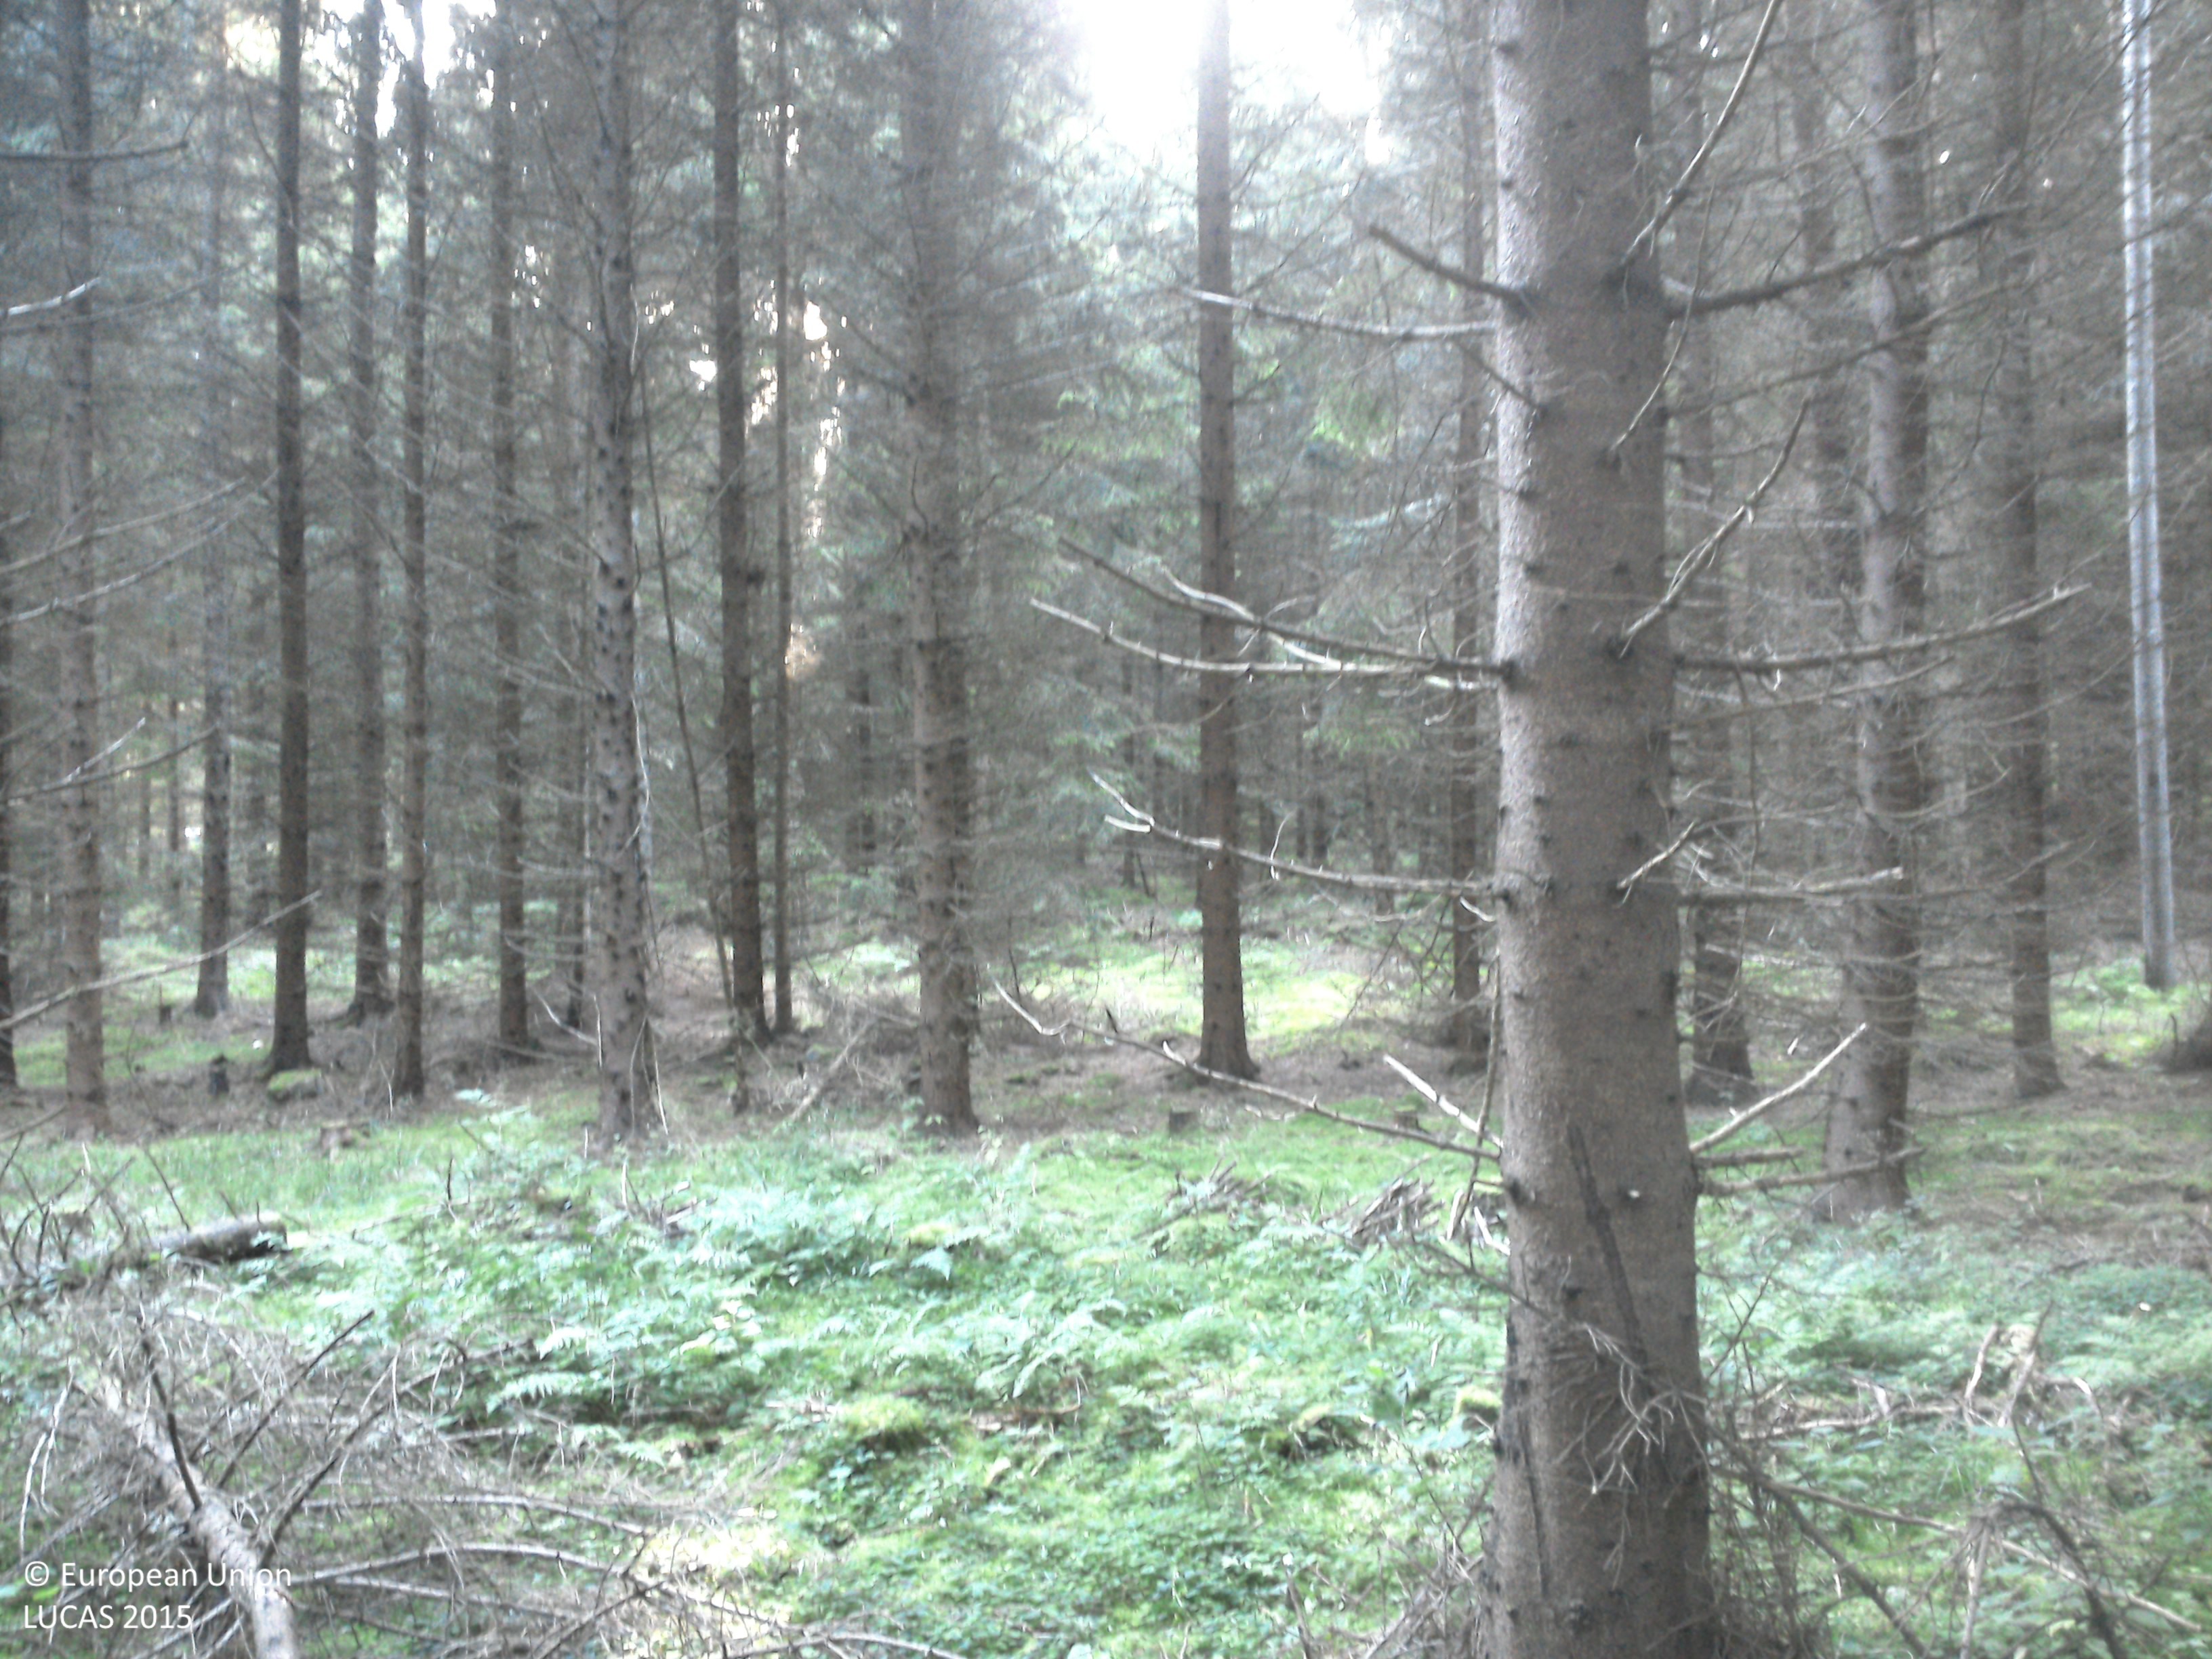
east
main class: Woodland
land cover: Spruce dominated coniferous woodland
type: boreal forest
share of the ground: > 75 %
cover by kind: coniferous forest trees 90 %, lichens and mosses 5 %, unconsolidated bare surface 5 %
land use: Forestry
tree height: > 5 m
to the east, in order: Spruce dominated coniferous woodland; Electric lines; Spruce dominated coniferous woodland; Paved roads, cycling and walking lanes; Spruce dominated coniferous woodland; Pine dominated coniferous woodland
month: August
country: SE
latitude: 57.9727
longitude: 15.2531
